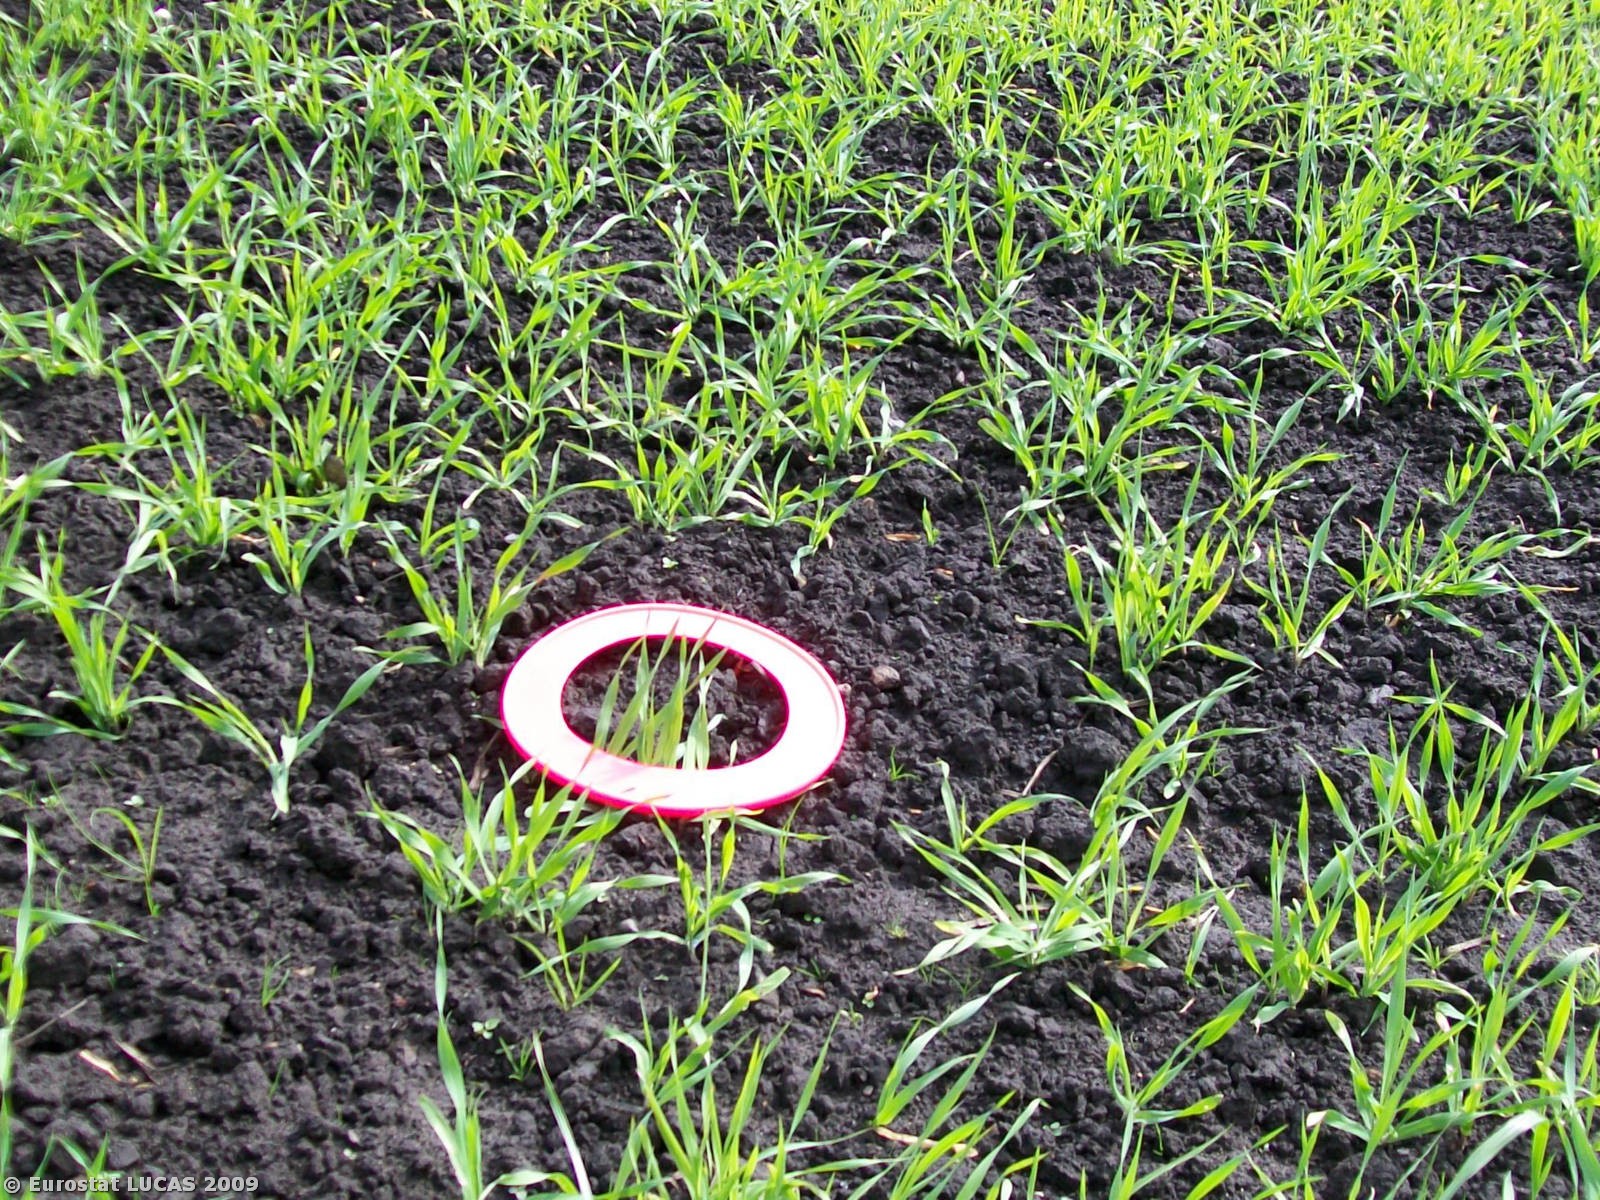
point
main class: Cropland
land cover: Barley
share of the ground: 50 - 75 %
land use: Agriculture (excluding fallow land and kitchen gardens)
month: April
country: GB
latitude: 53.5044
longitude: -2.7802
